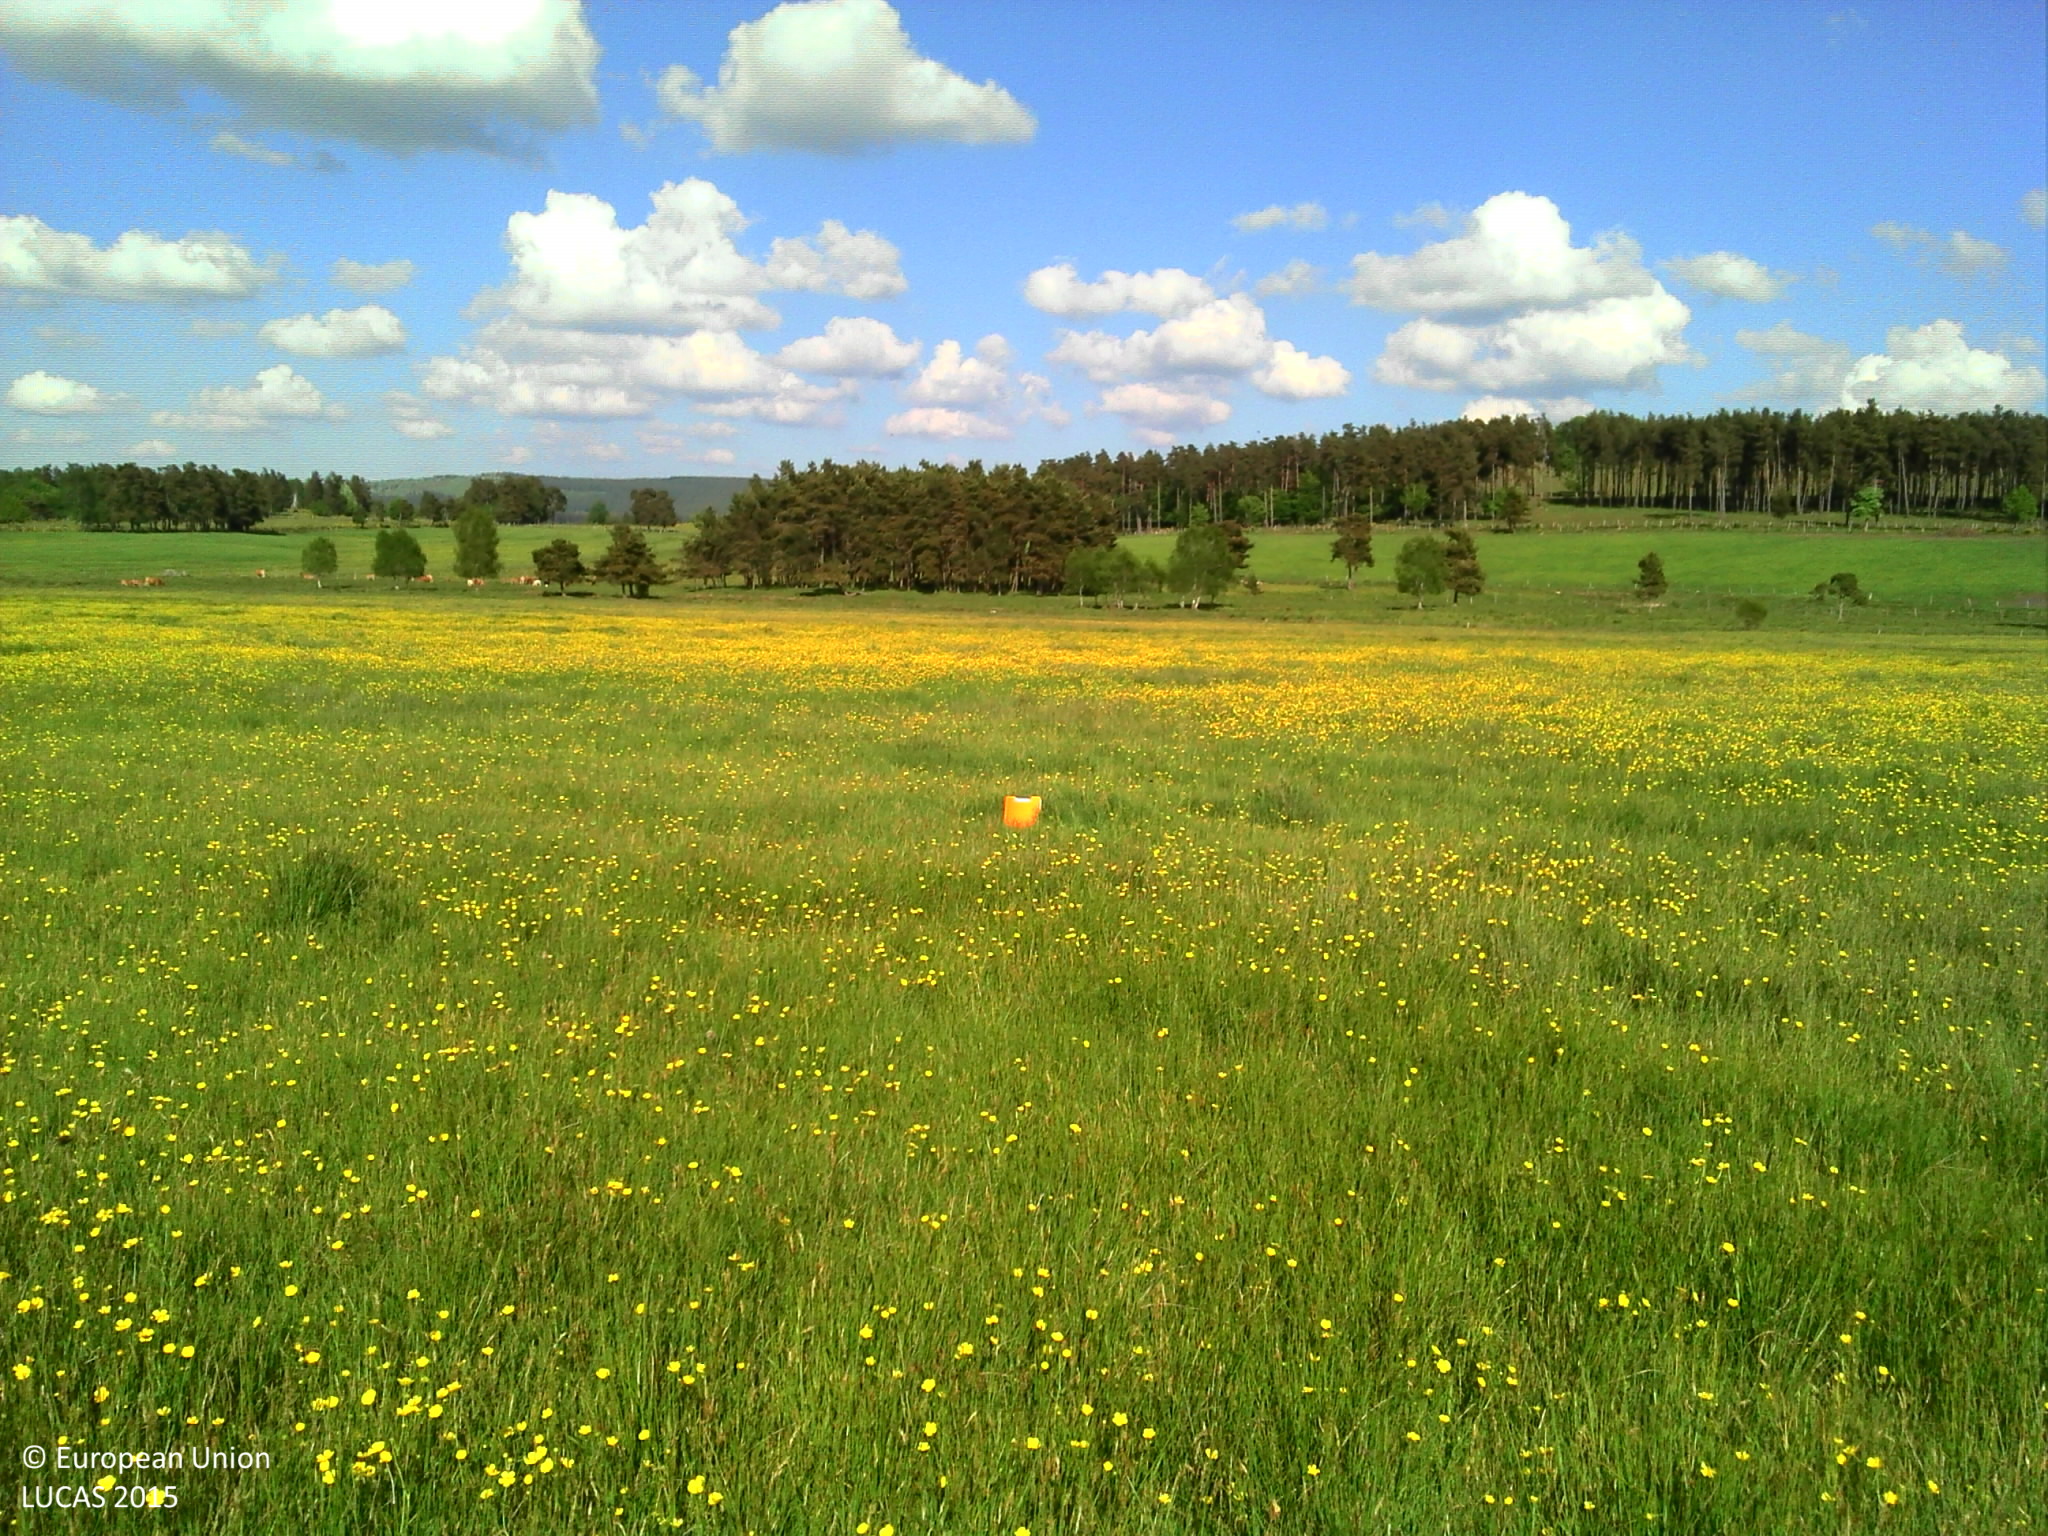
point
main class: Grassland
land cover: Grassland without tree/shrub cover
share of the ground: > 75 %
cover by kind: herbaceous plants 100 %
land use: Agriculture (excluding fallow land and kitchen gardens)
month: June
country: FR
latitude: 44.7794
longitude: 2.9384
